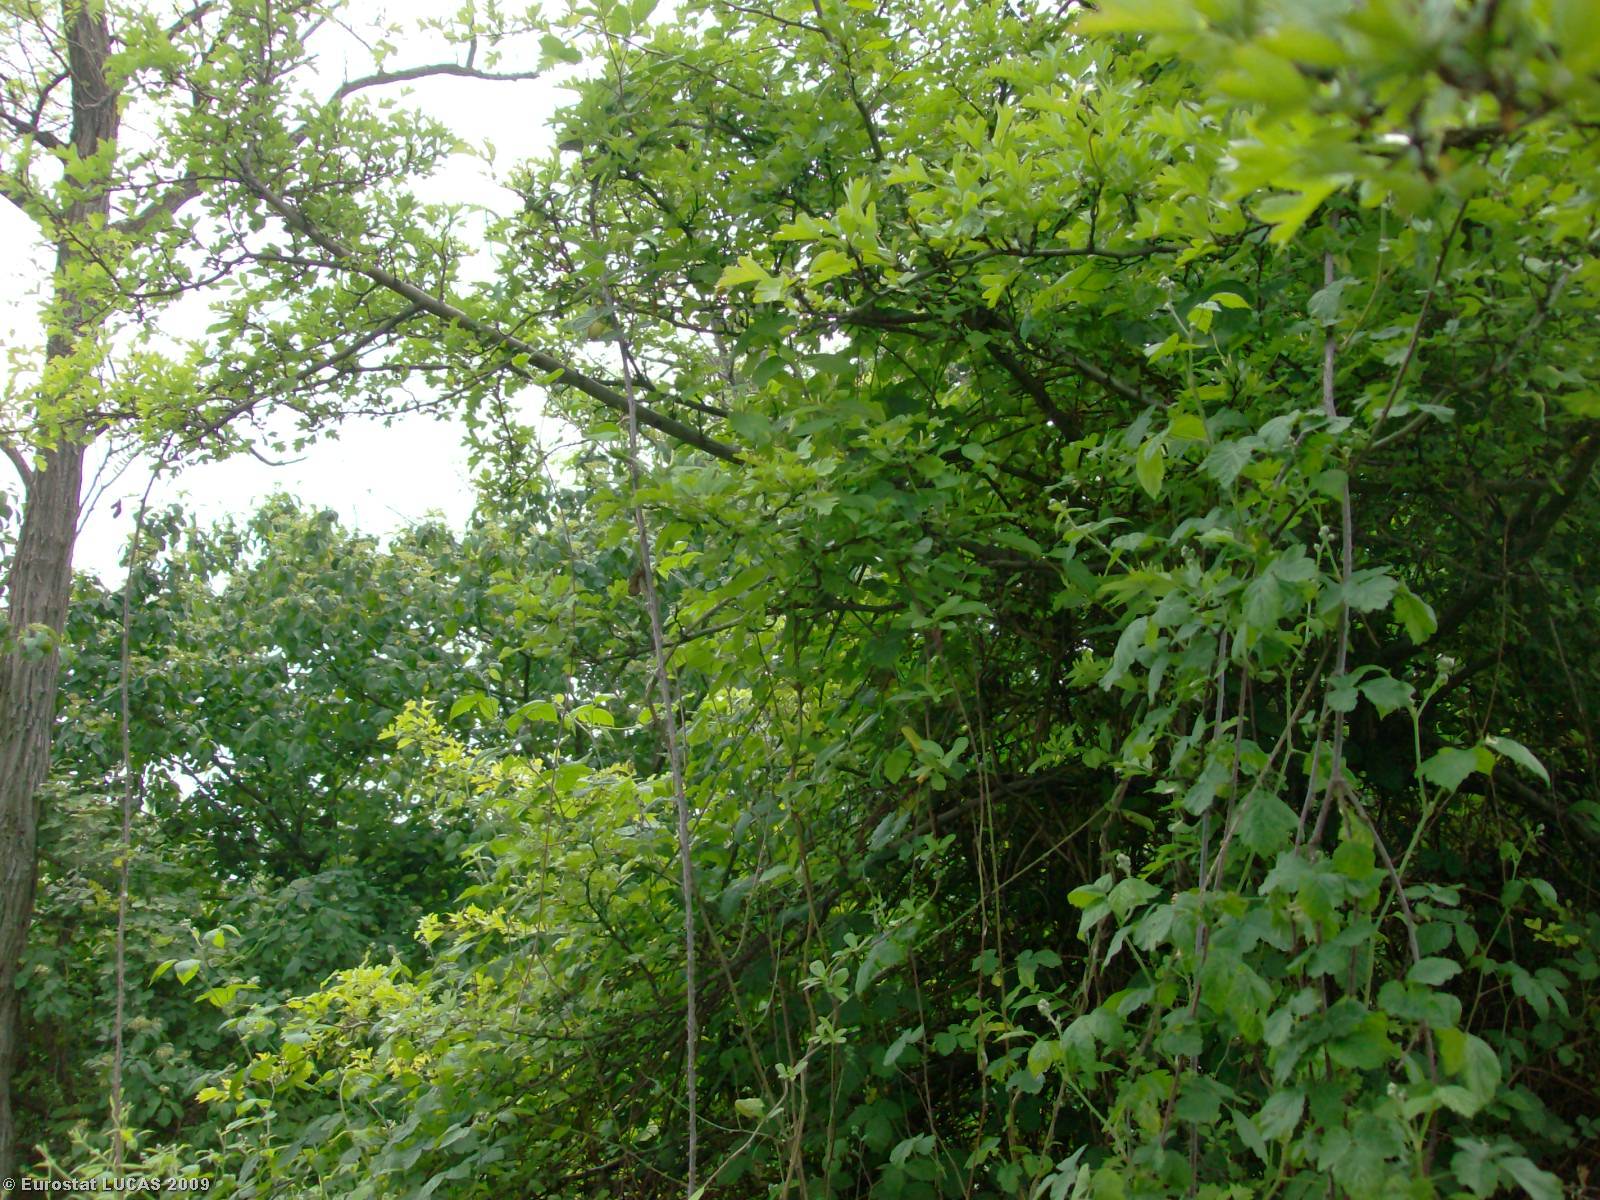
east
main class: Woodland
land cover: Mixed woodland
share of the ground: > 75 %
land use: Unused
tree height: > 5 m
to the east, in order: Mixed woodland; Ditches and canals; Managed hedges; Tracks; Mixed woodland; Tracks; Mixed woodland; Grass margins; Rivers and streams
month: May
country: IT
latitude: 45.6657
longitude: 9.5771
